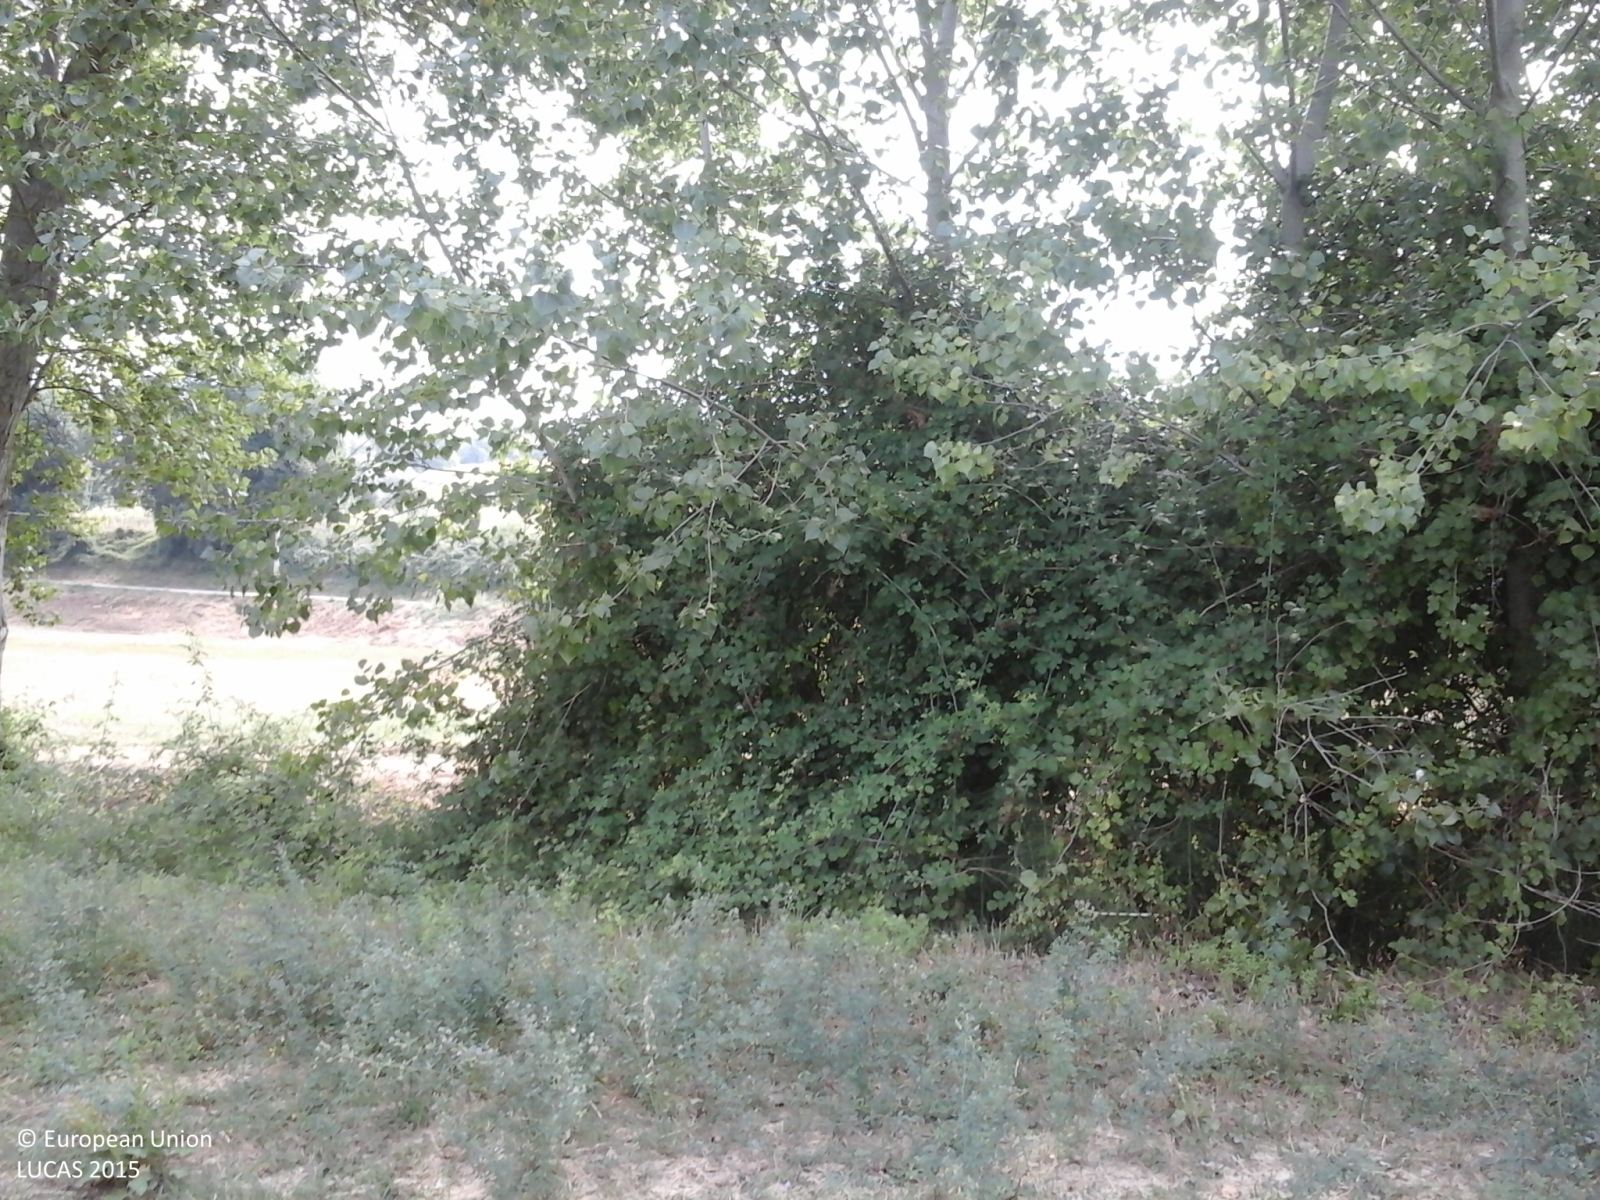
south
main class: Cropland
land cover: Lucerne
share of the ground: > 75 %
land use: Agriculture (excluding fallow land and kitchen gardens)
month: August
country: IT
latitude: 43.4982
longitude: 13.4667
